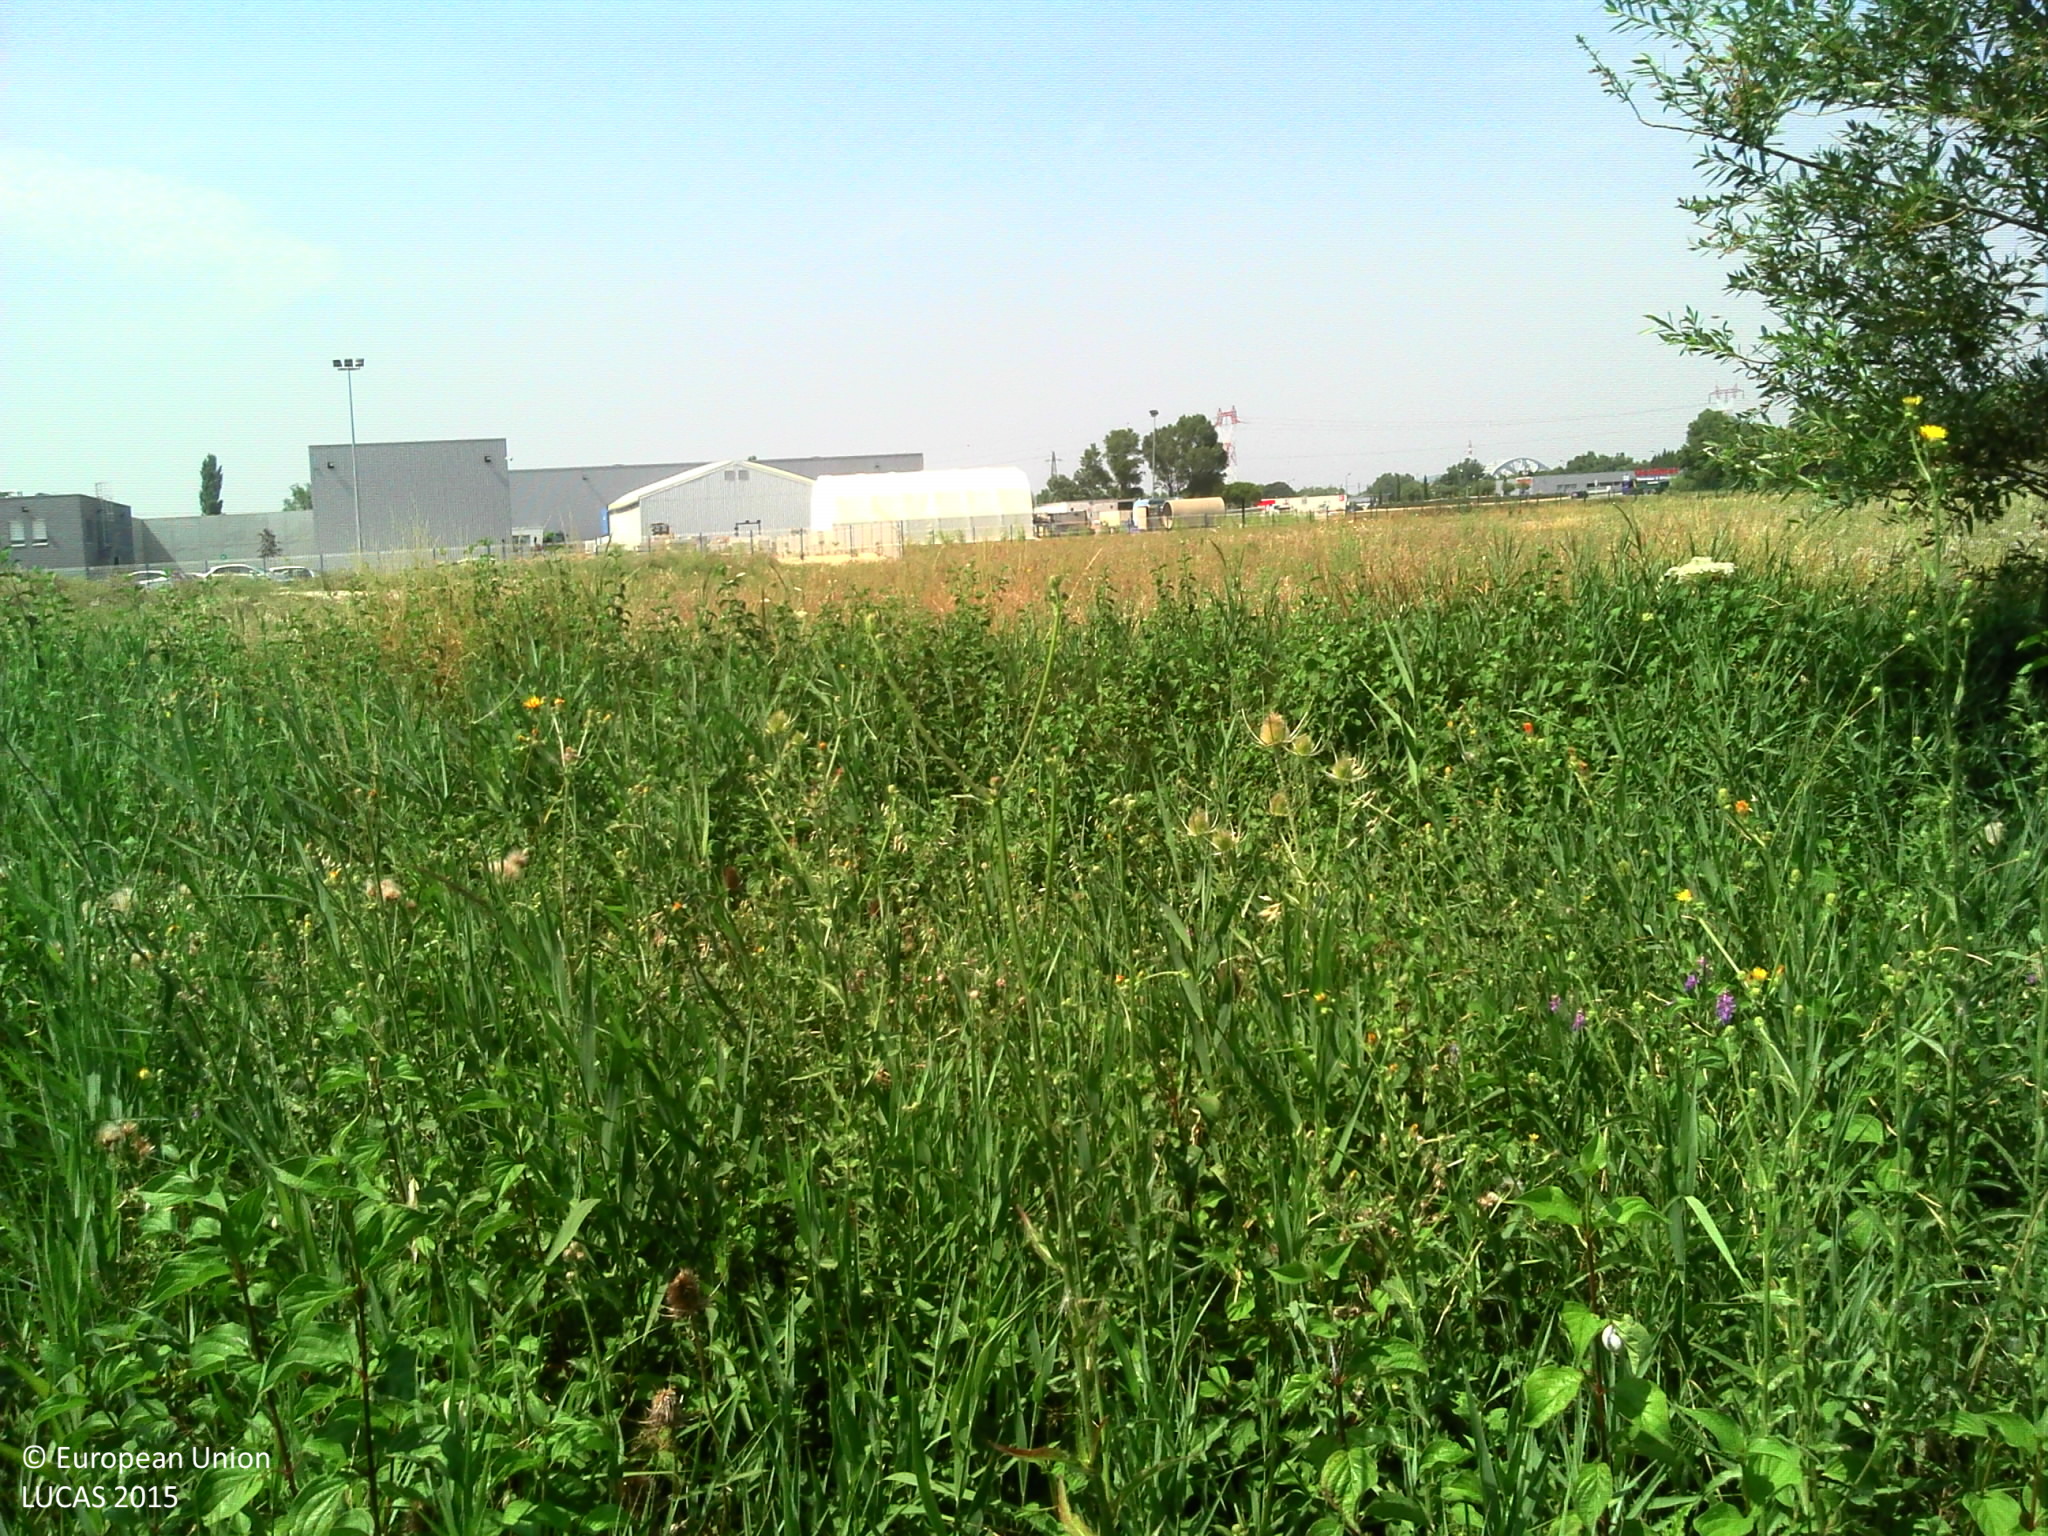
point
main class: Grassland
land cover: Spontaneously vegetated surfaces
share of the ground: > 75 %
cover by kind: herbaceous plants 100 %
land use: Semi-natural and natural areas not in use
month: July
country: FR
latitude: 44.3610
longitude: 4.7249
